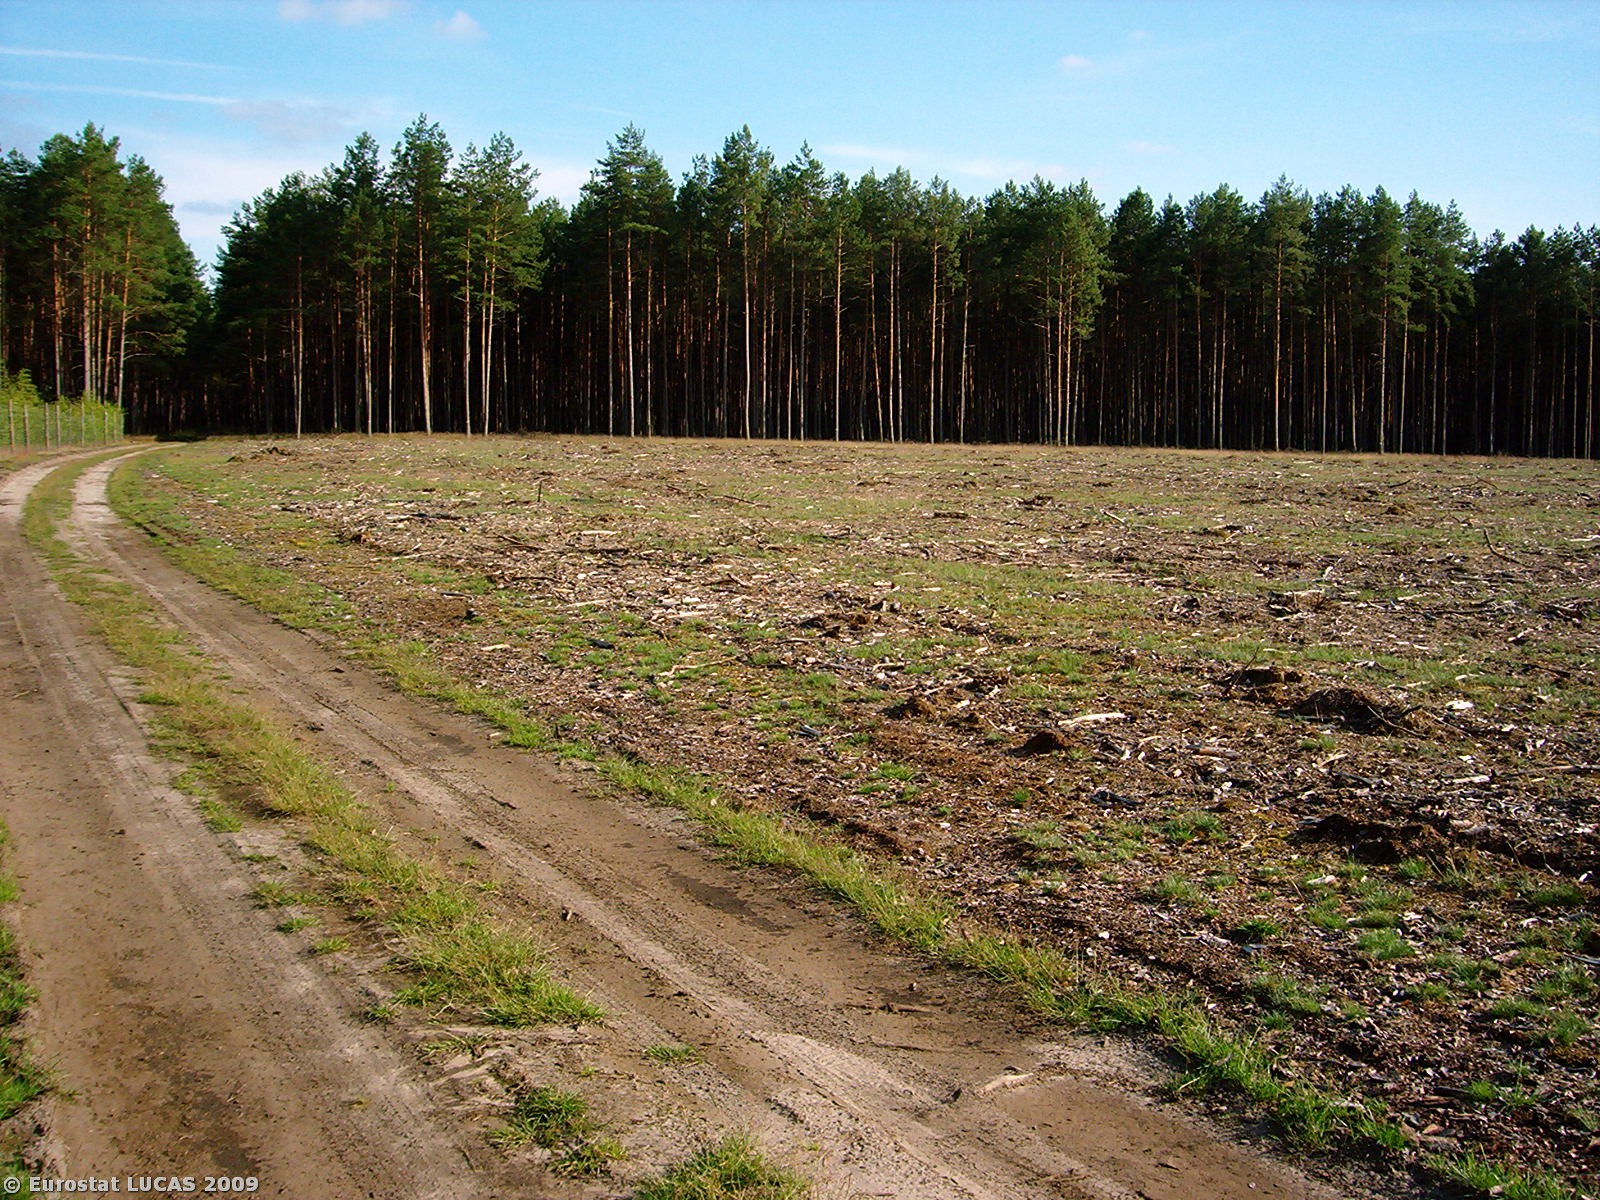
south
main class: Woodland
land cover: Mixed woodland
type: hemiboreal forest and nemoral coniferous forest and mixed broadleaved-coniferous forest
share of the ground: 25 - 50 %
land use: Forestry
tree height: > 5 m
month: June
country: PL
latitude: 53.2017
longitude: 15.9482
